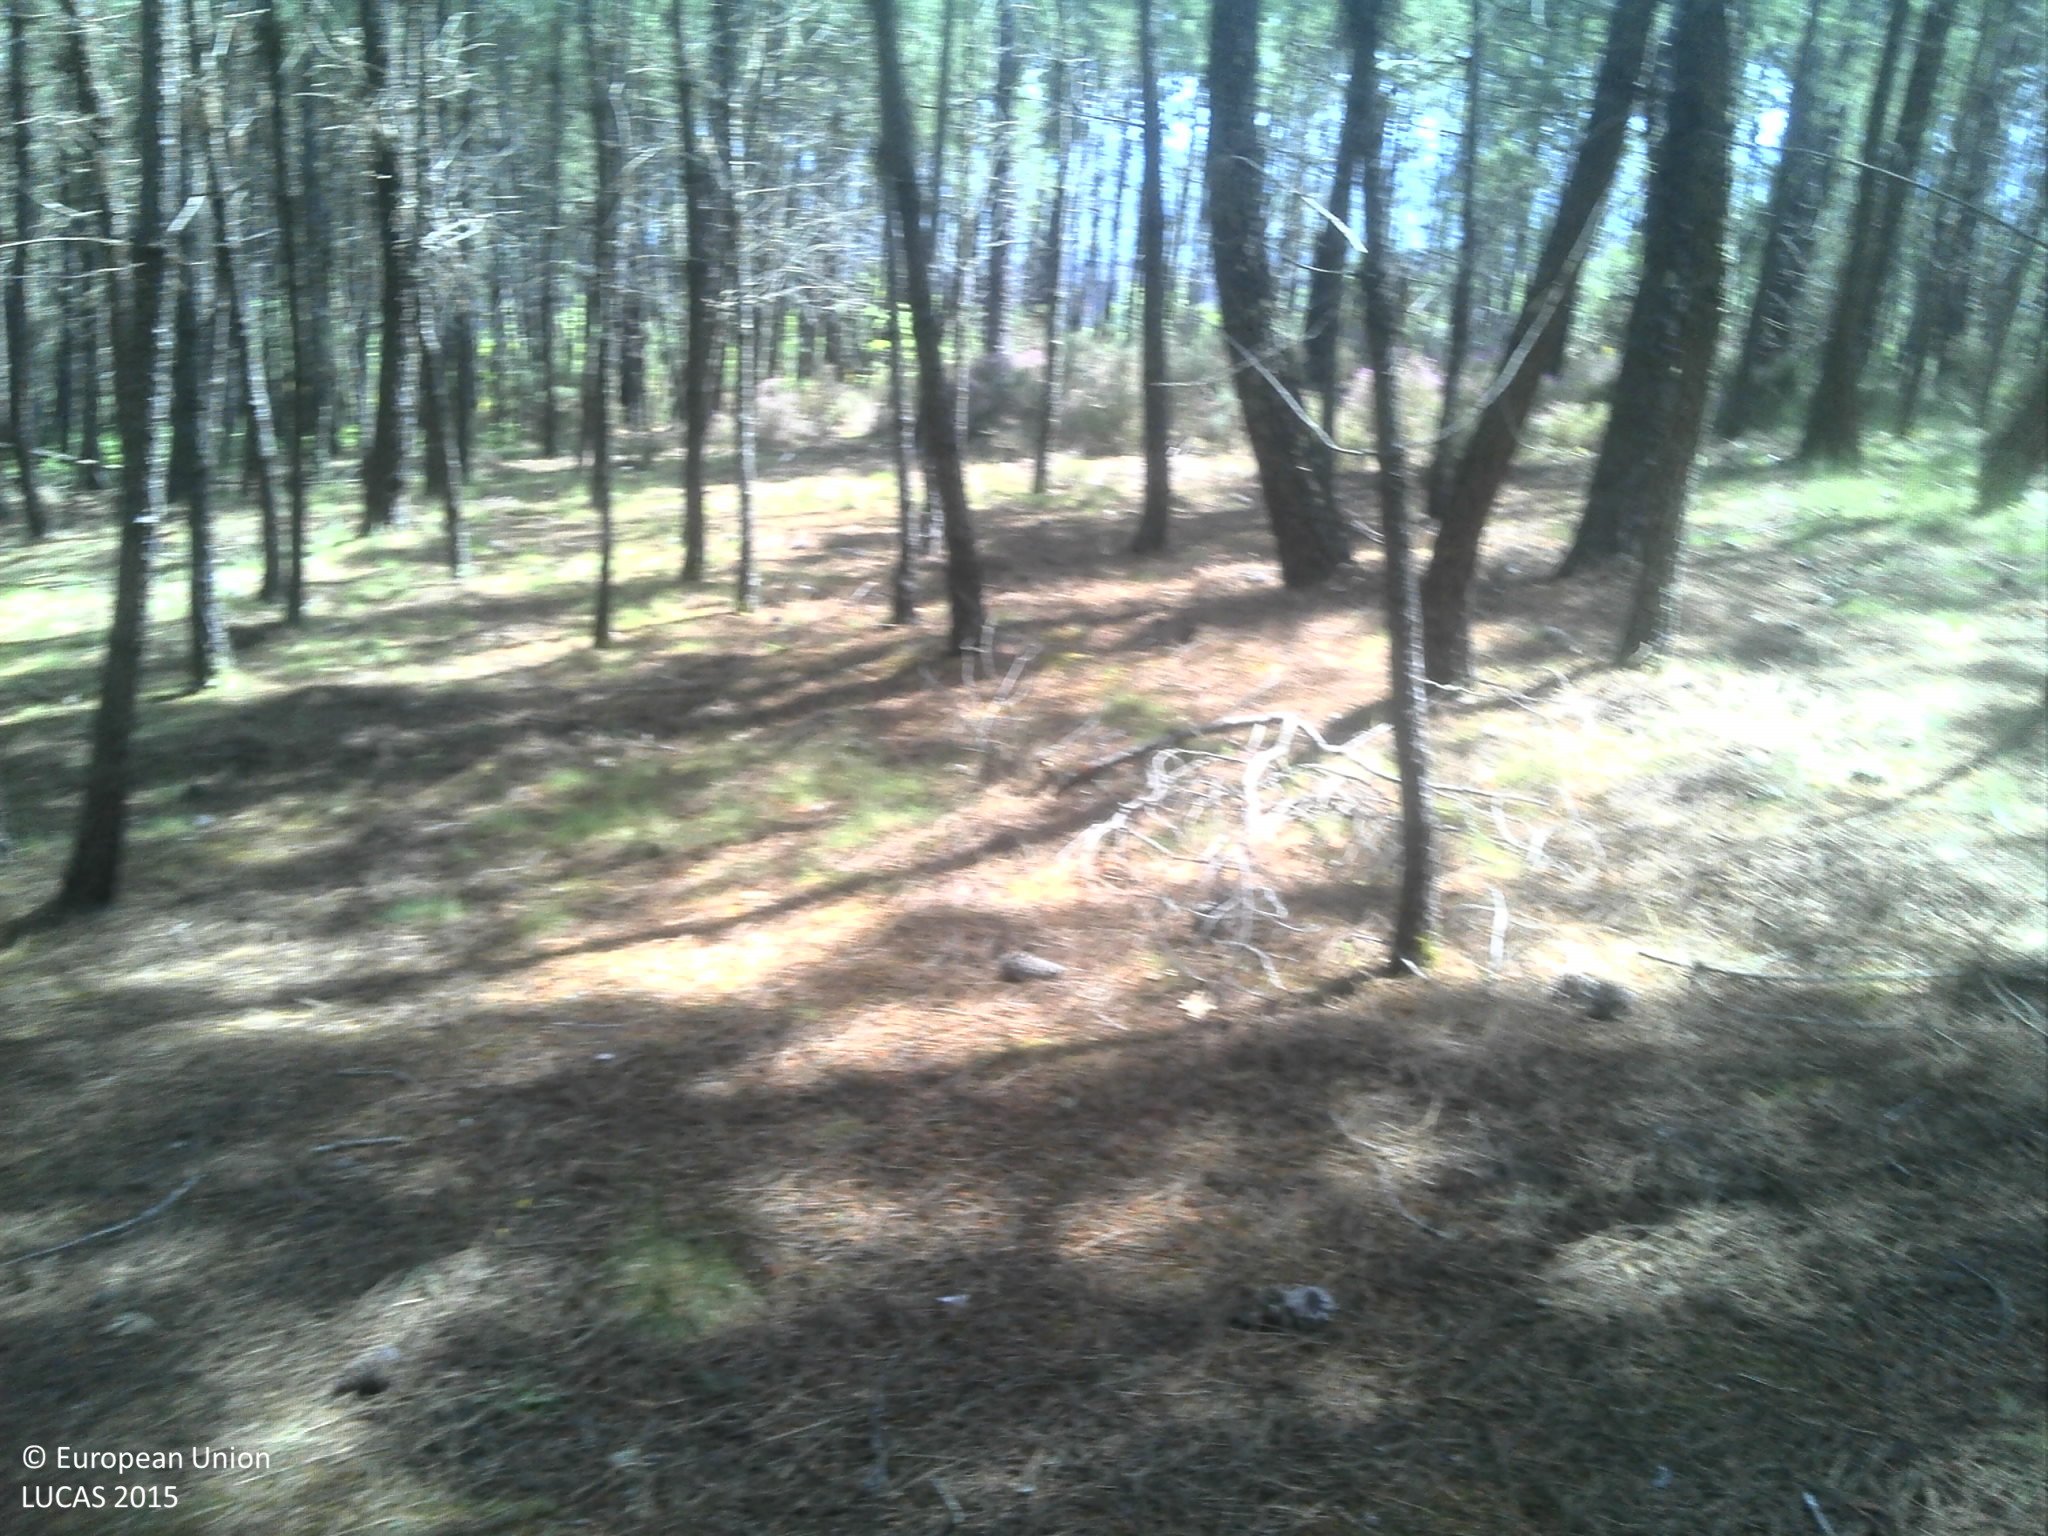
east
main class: Woodland
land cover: Pine dominated coniferous woodland
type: coniferous forest of the mediterranean region
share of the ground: > 75 %
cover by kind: coniferous forest trees 90 %, shrubs 10 %
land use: Forestry
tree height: > 5 m
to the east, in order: Pine dominated coniferous woodland; Shrubland without tree cover; Pine dominated coniferous woodland; Tracks; Shrubland without tree cover; Tracks; Shrubland without tree cover; Pine dominated coniferous woodland
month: May
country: PT
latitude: 40.6907
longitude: -7.8132
